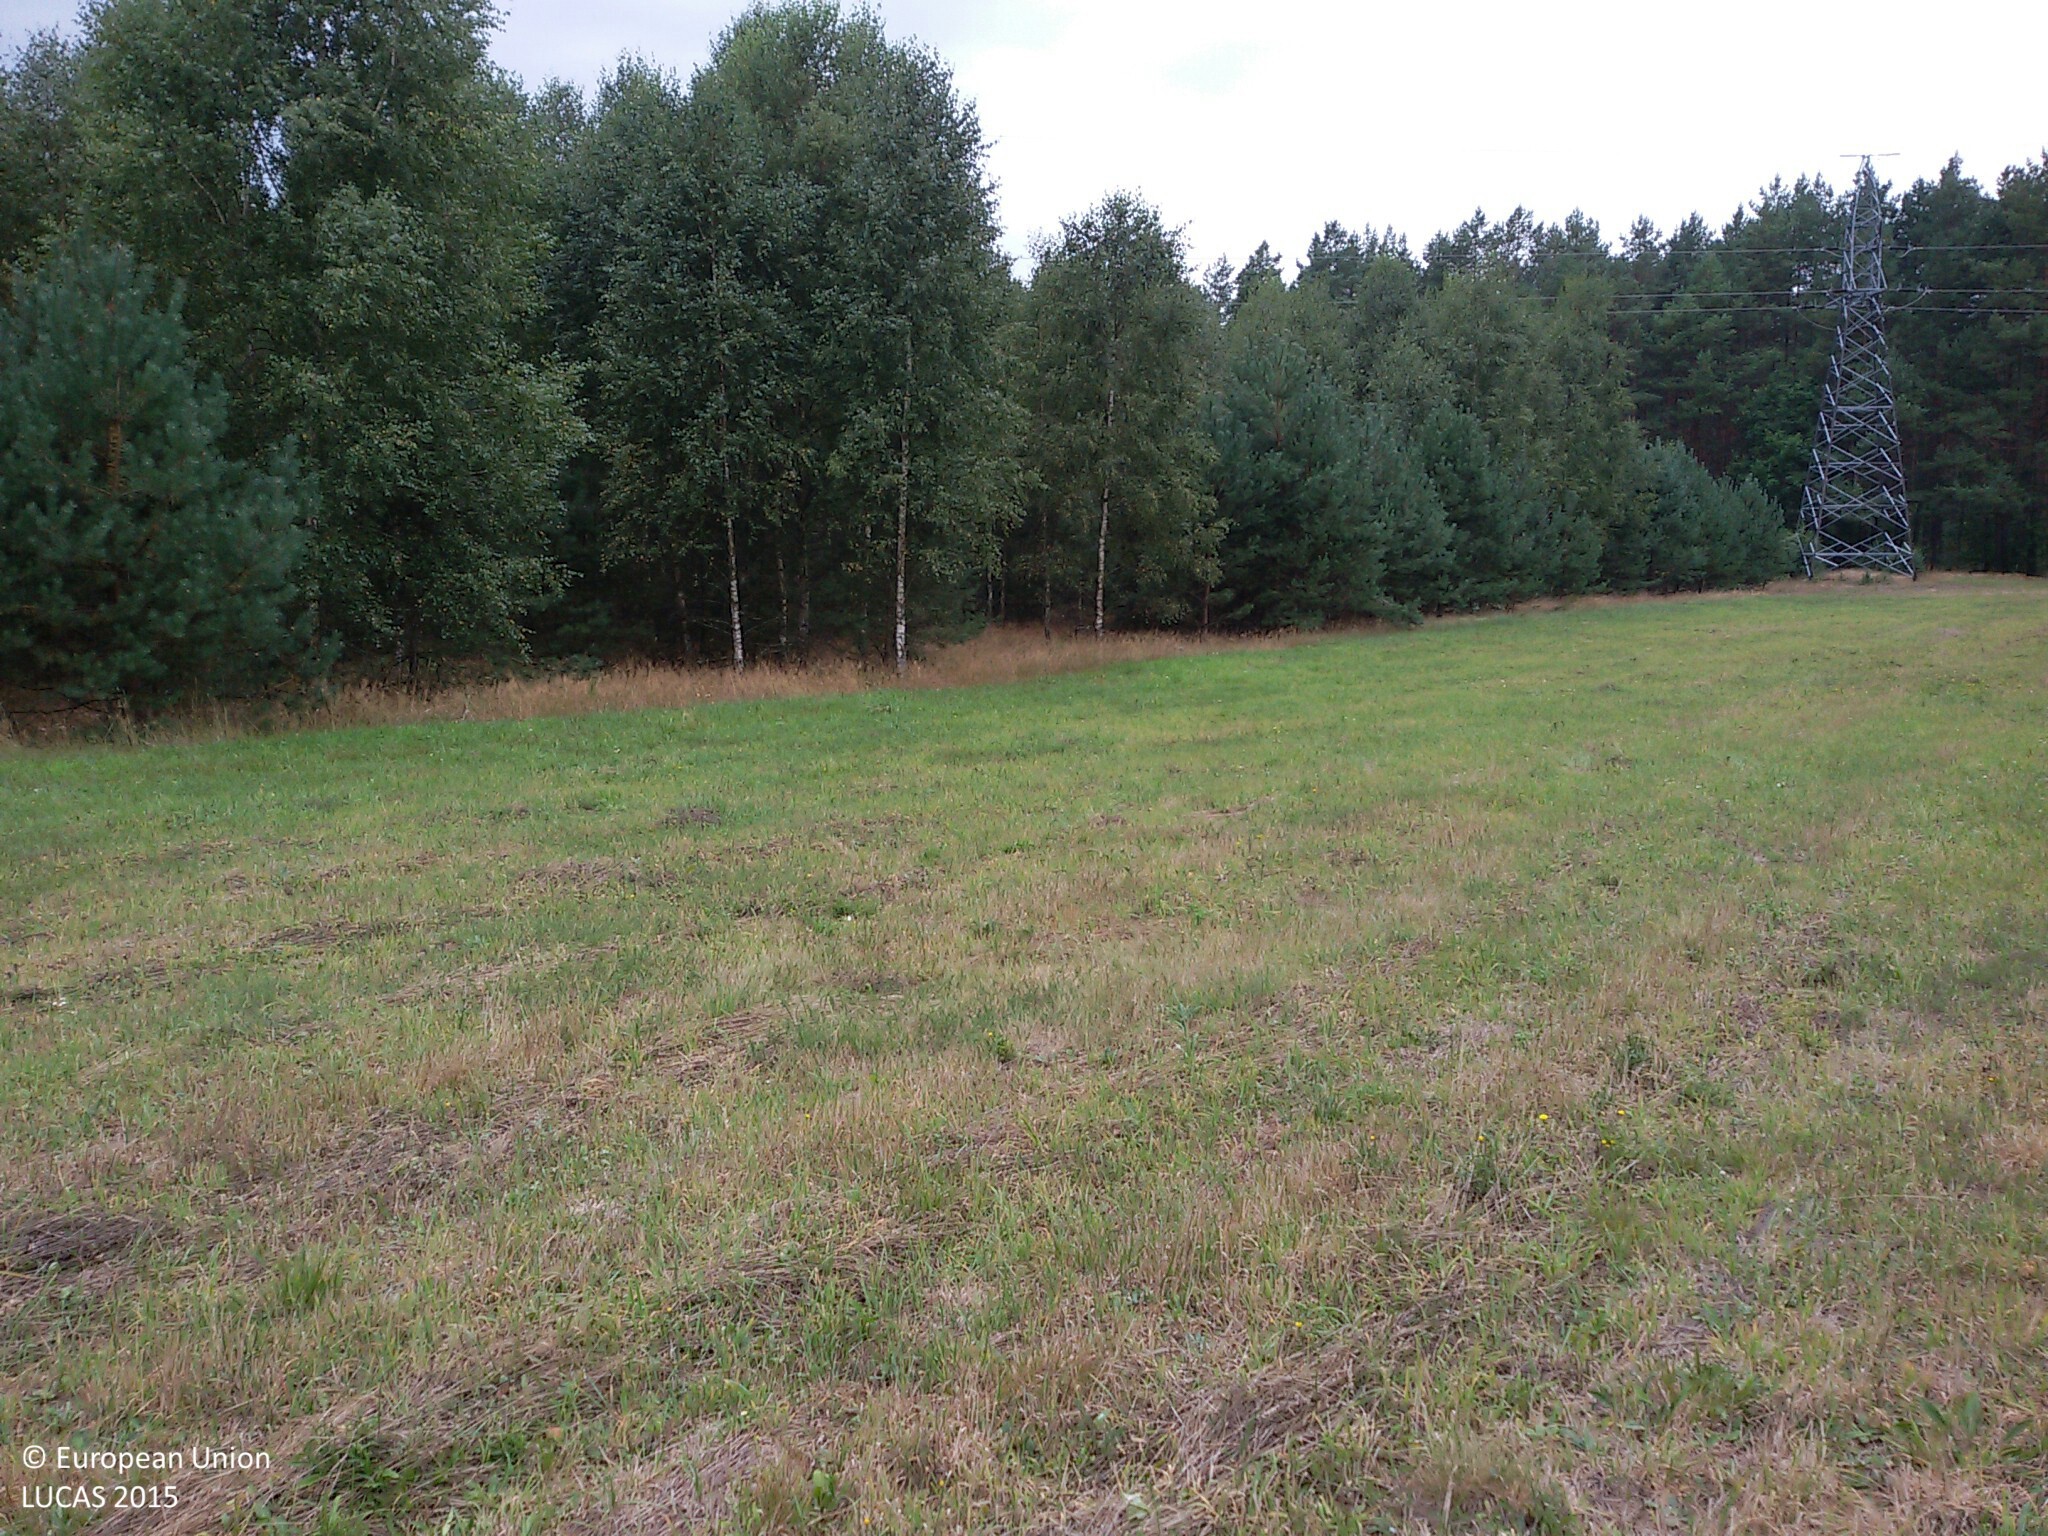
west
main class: Grassland
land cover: Grassland without tree/shrub cover
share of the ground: > 75 %
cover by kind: herbaceous plants 90 %, unconsolidated bare surface 10 %
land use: Agriculture (excluding fallow land and kitchen gardens)
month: September
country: PL
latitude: 53.7666
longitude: 20.2133
